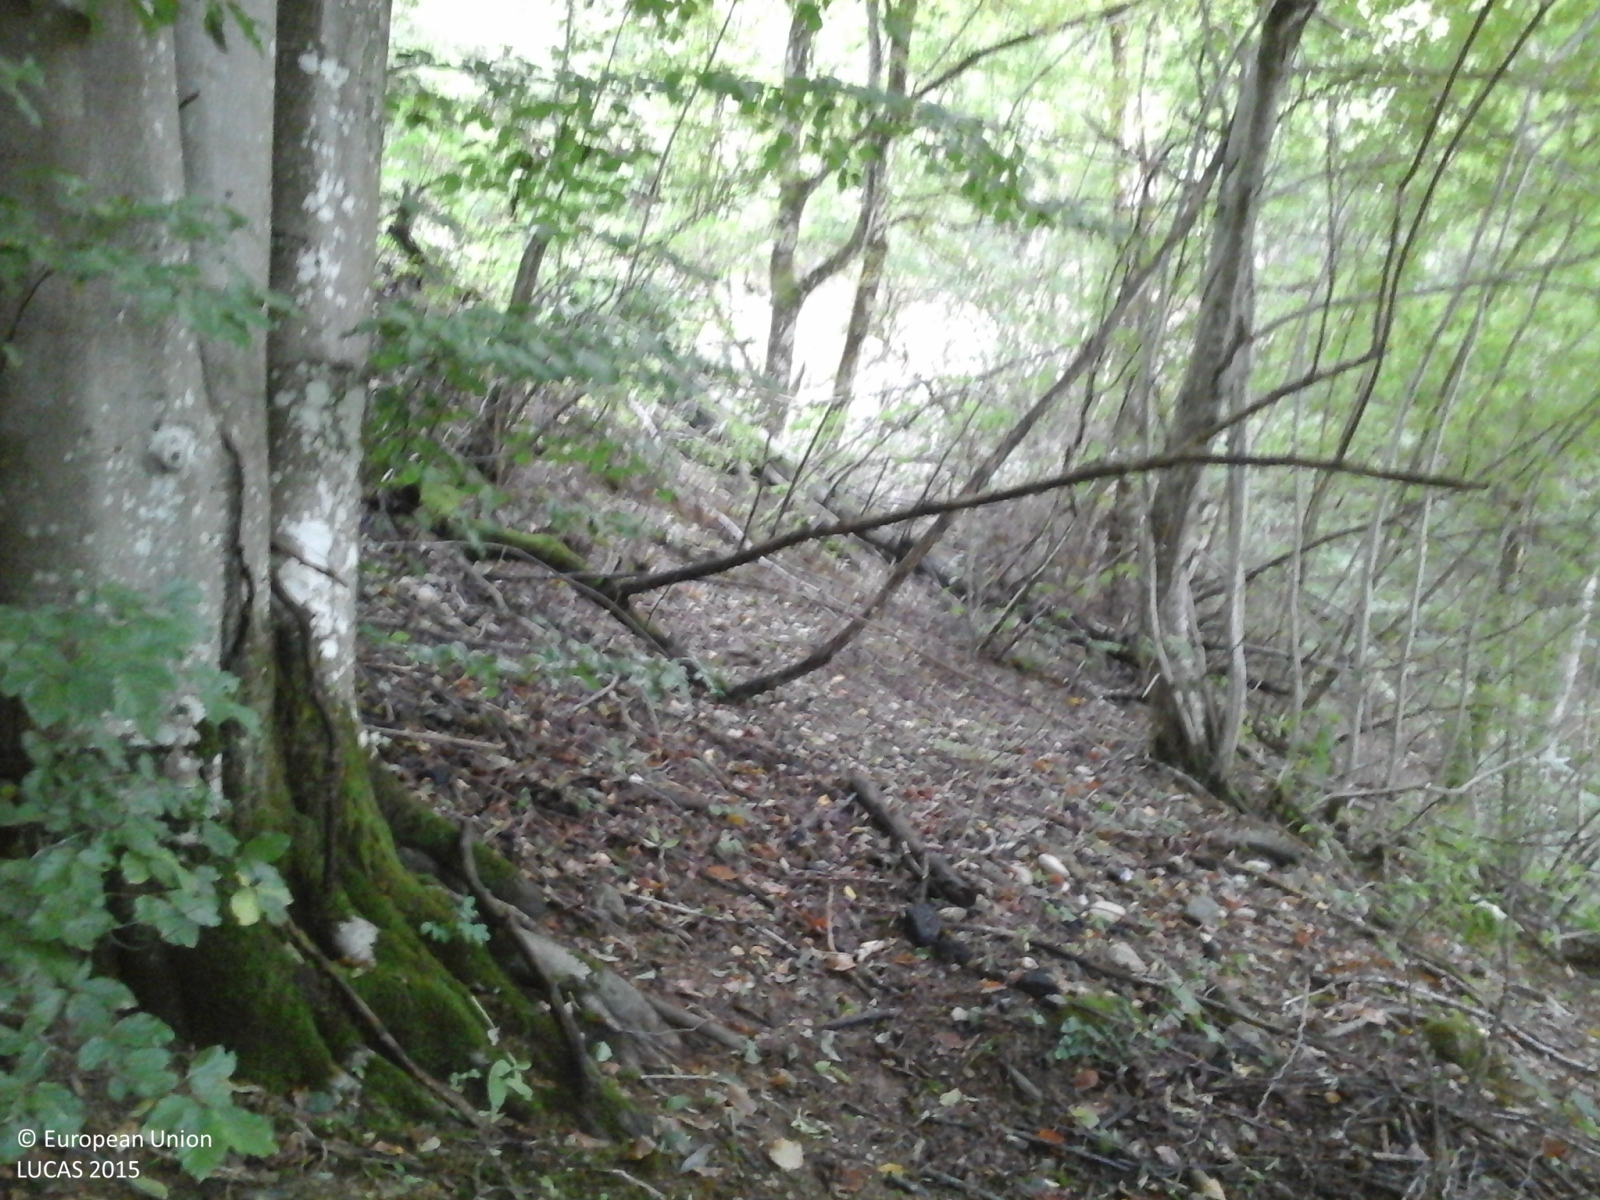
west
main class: Woodland
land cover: Broadleaved woodland
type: thermophilous deciduous forest
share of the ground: > 75 %
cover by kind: broadleaved forest trees 100 %
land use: Semi-natural and natural areas not in use
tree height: > 5 m
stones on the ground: 10 - 25 %
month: September
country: IT
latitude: 44.5099
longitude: 9.2093
